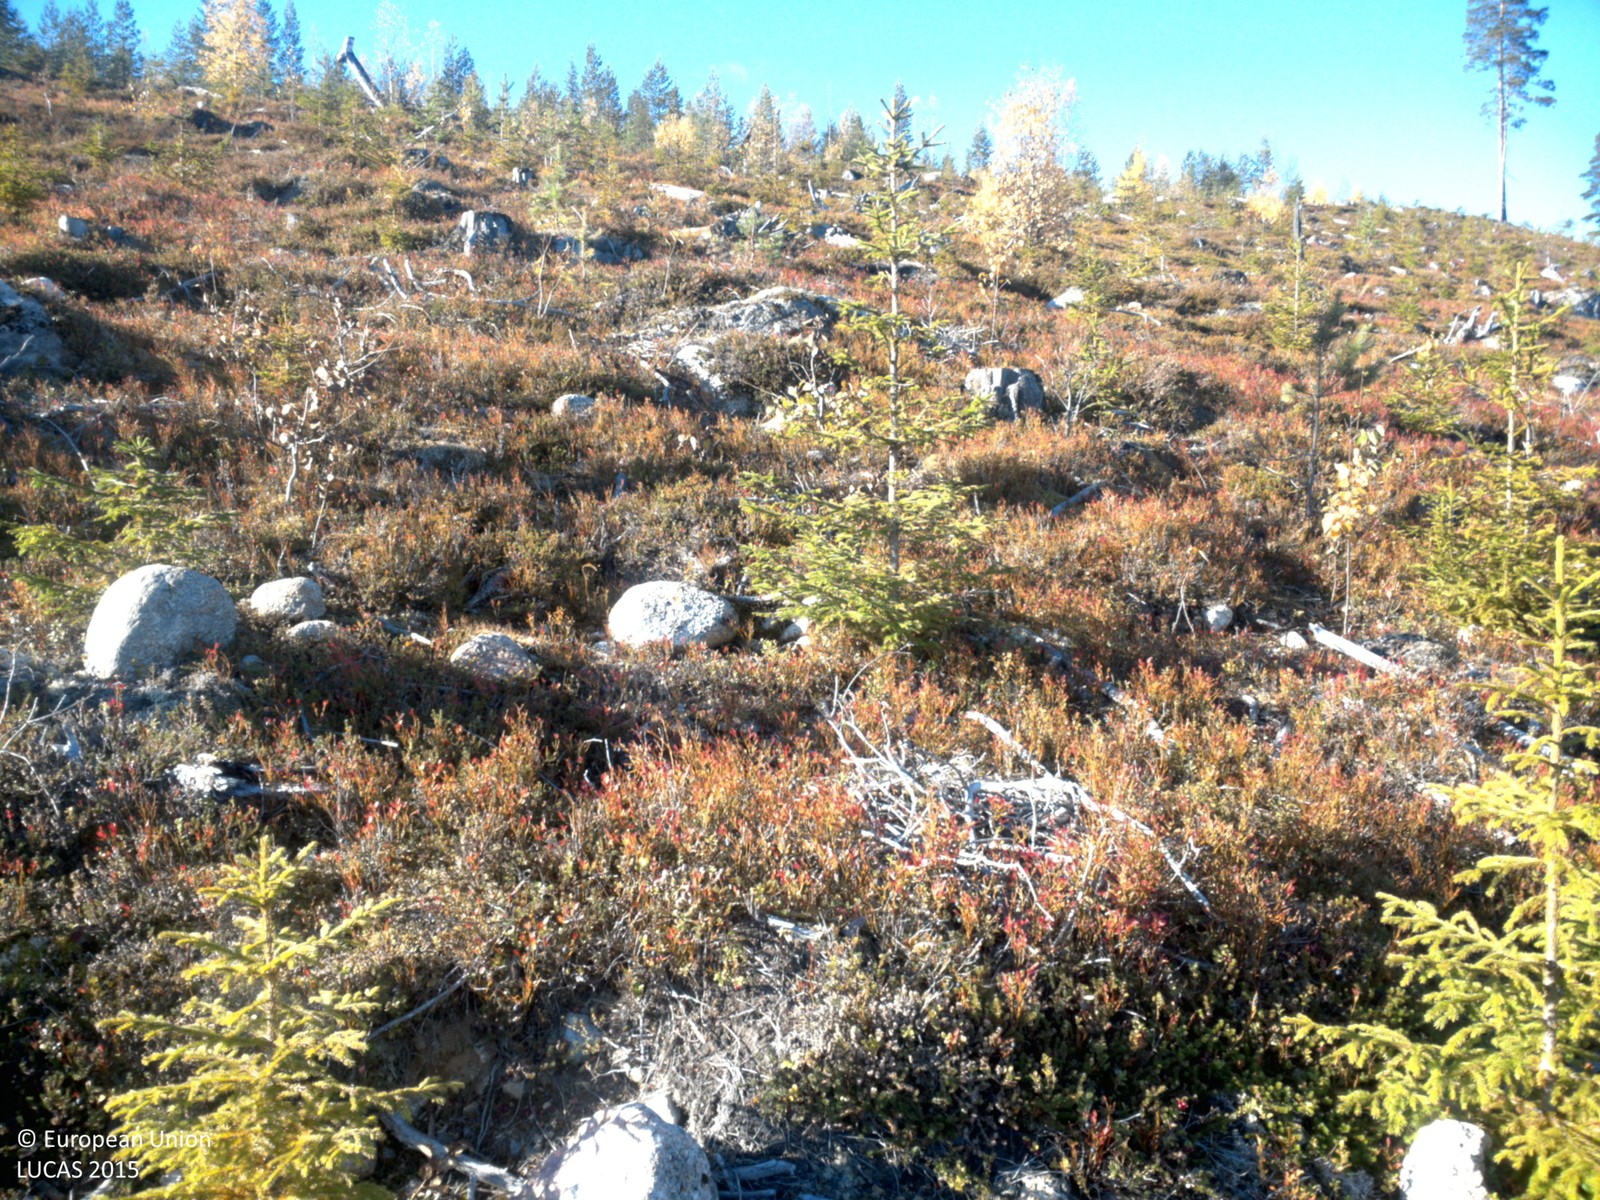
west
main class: Shrubland
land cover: Shrubland with sparse tree cover
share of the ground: > 75 %
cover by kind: shrubs 80 %, lichens and mosses 10 %, coniferous forest trees 5 %, herbaceous plants 5 %
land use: Forestry
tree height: < 5 m
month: October
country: SE
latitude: 64.7689
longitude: 18.5235
